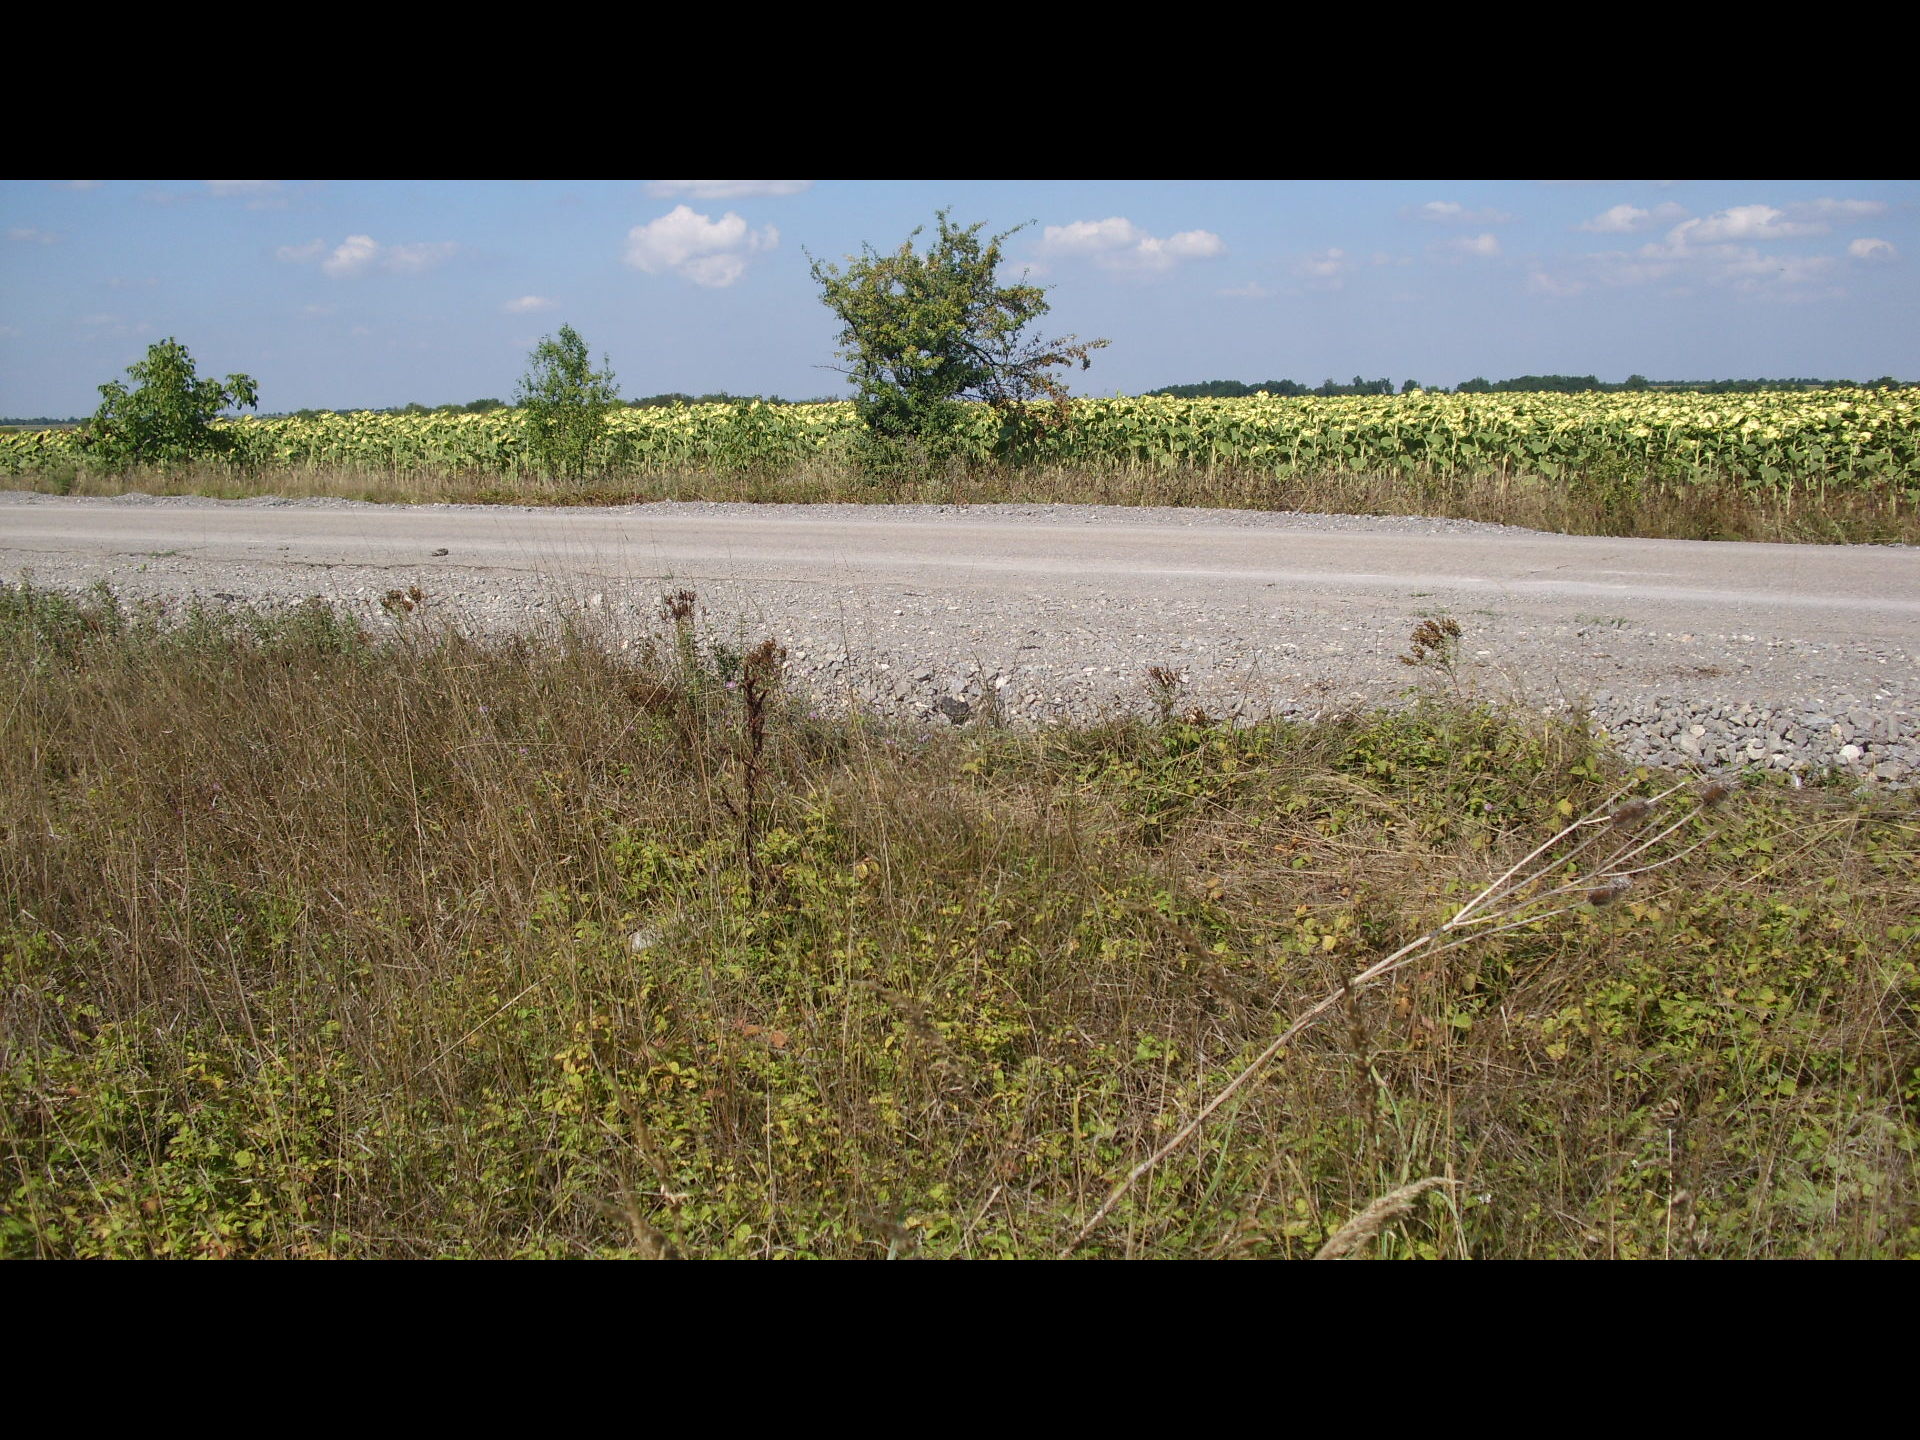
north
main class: Grassland
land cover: Grassland without tree/shrub cover
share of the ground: > 75 %
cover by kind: herbaceous plants 100 %
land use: Agriculture (excluding fallow land and kitchen gardens)
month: August
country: BG
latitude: 43.5862
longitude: 22.9801
